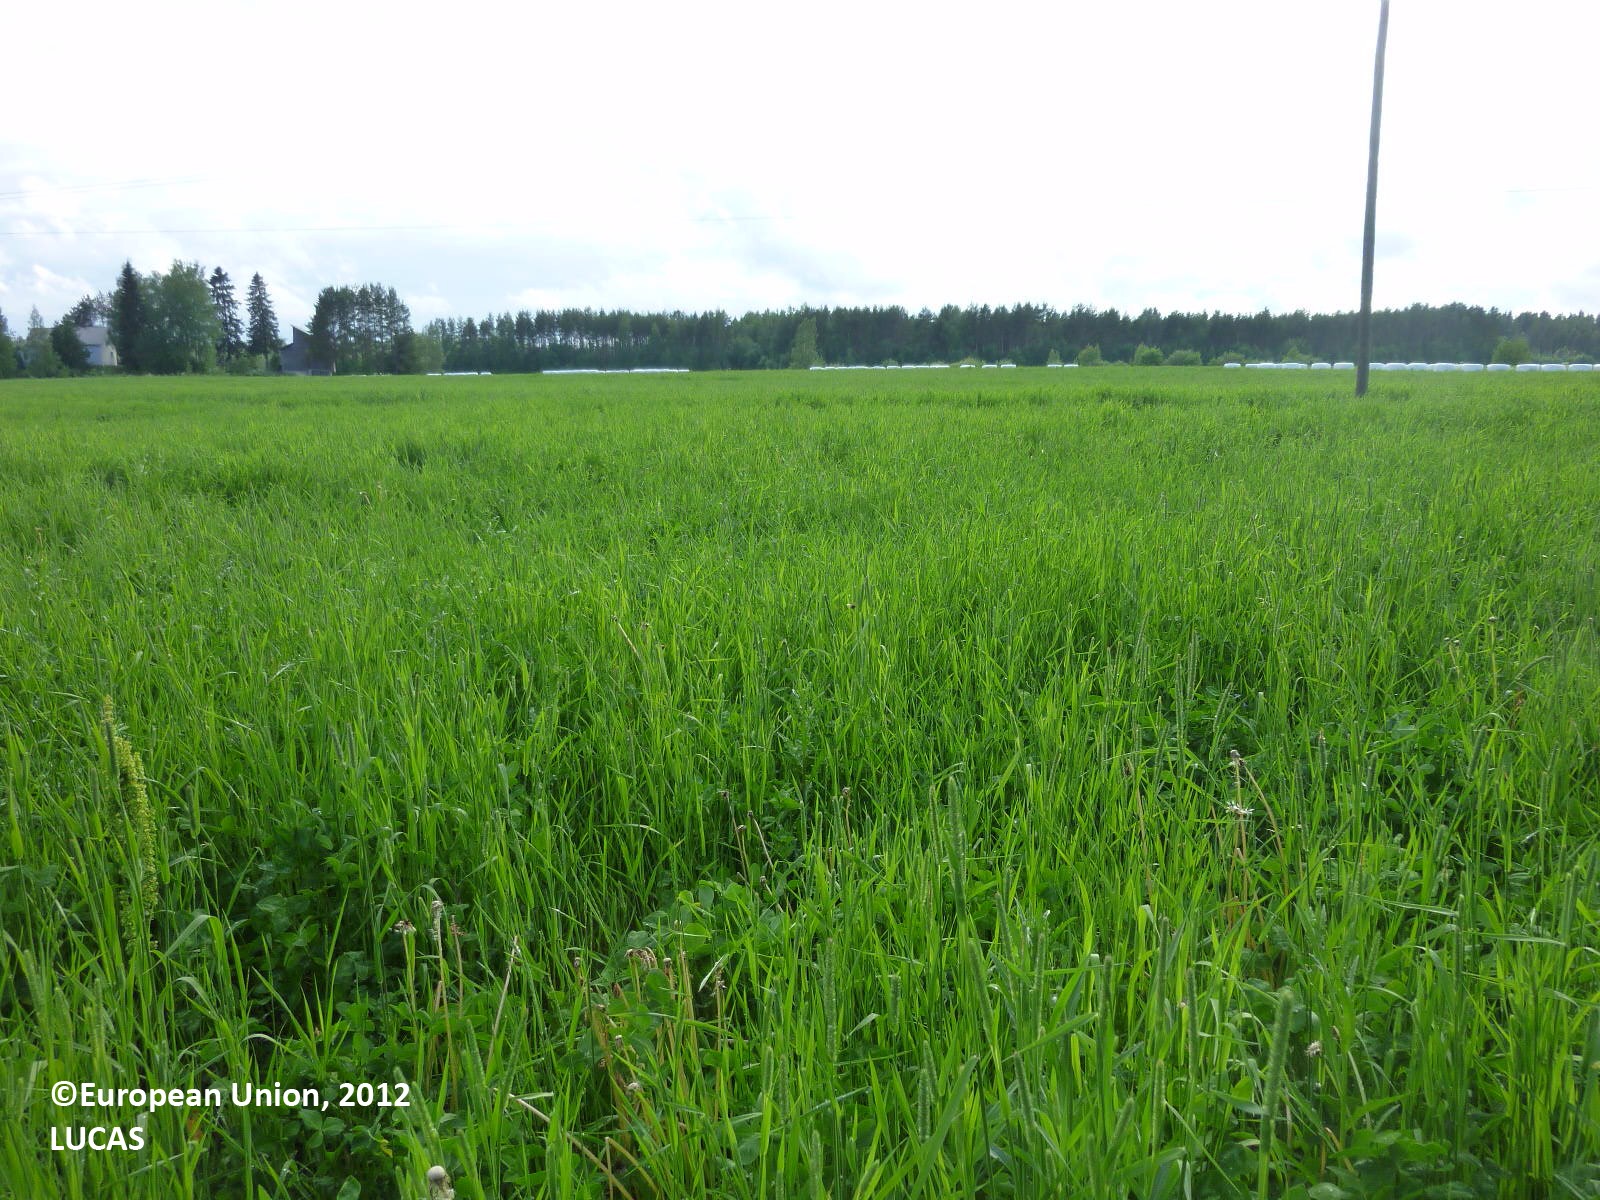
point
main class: Cropland
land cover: Temporary grasslands
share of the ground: 50 - 75 %
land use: Agriculture (excluding fallow land and kitchen gardens)
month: June
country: FI
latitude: 61.5968
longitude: 22.4815
